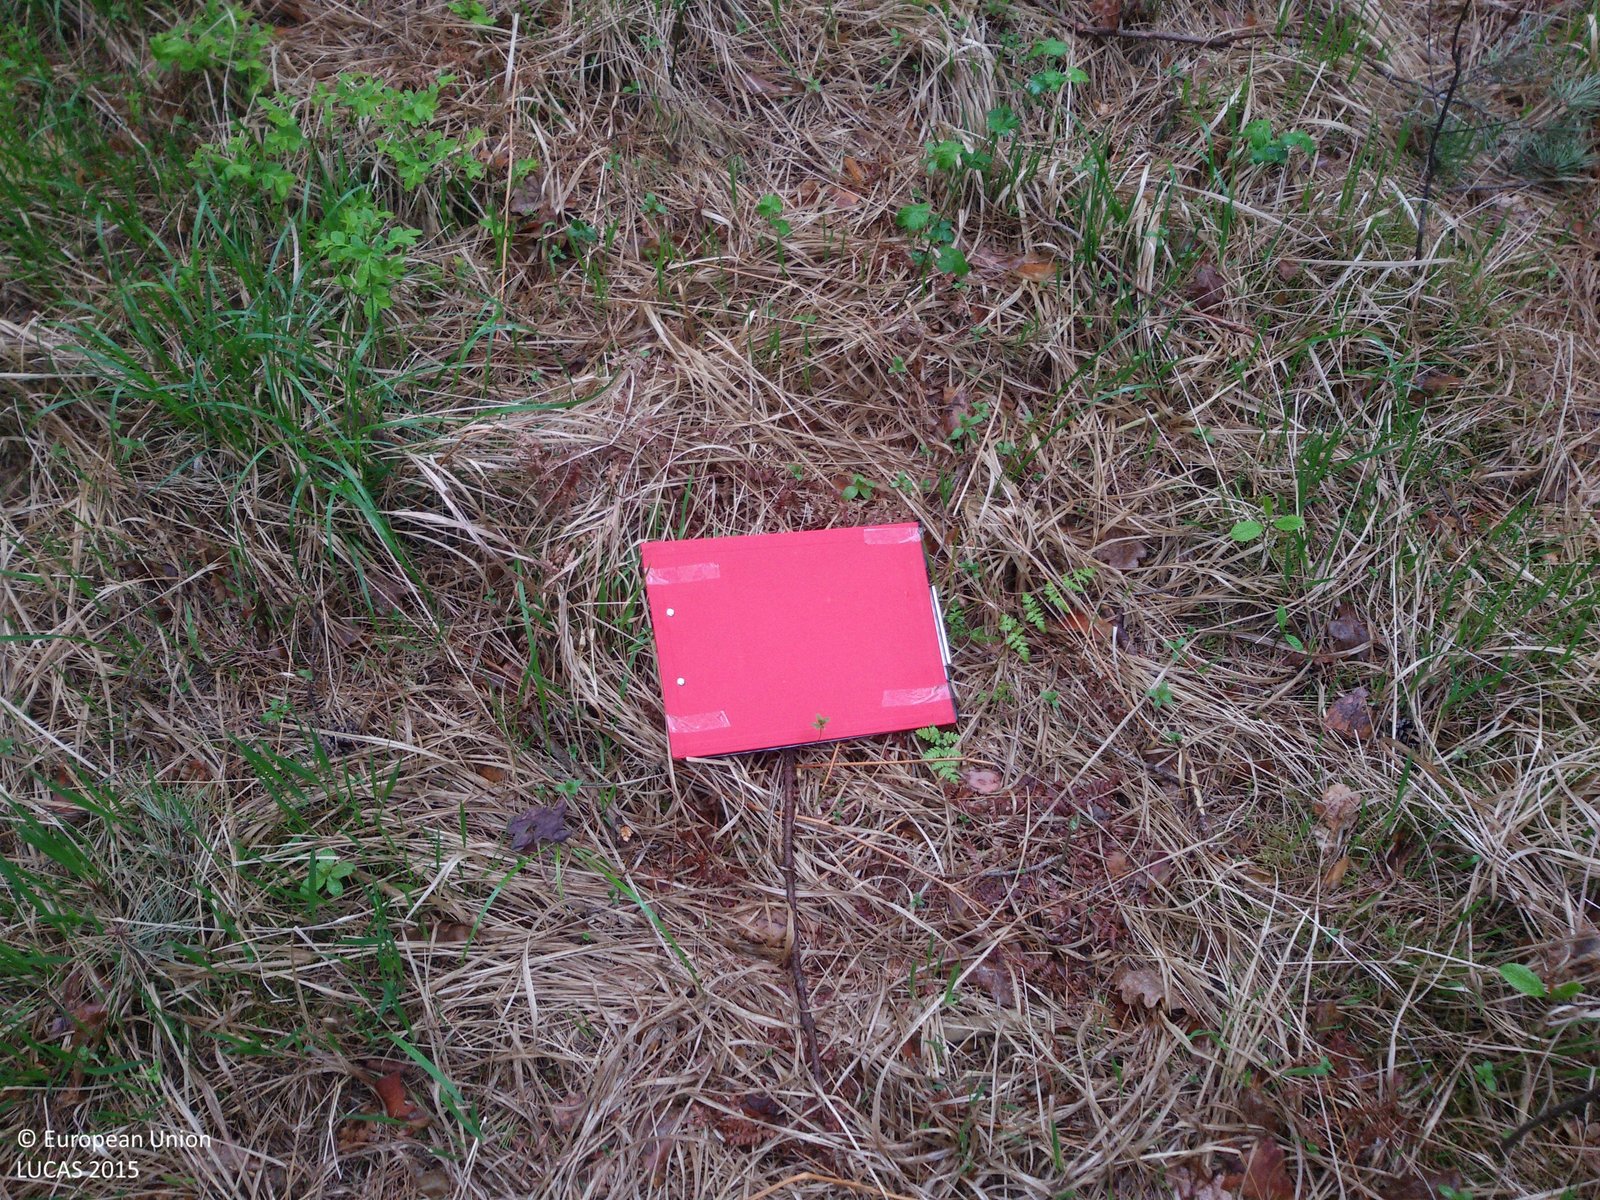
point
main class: Woodland
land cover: Pine dominated coniferous woodland
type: hemiboreal forest and nemoral coniferous forest and mixed broadleaved-coniferous forest
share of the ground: > 75 %
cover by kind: coniferous forest trees 85 %, herbaceous plants 15 %
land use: Forestry
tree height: > 5 m
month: May
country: PL
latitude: 50.3894
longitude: 21.5997
